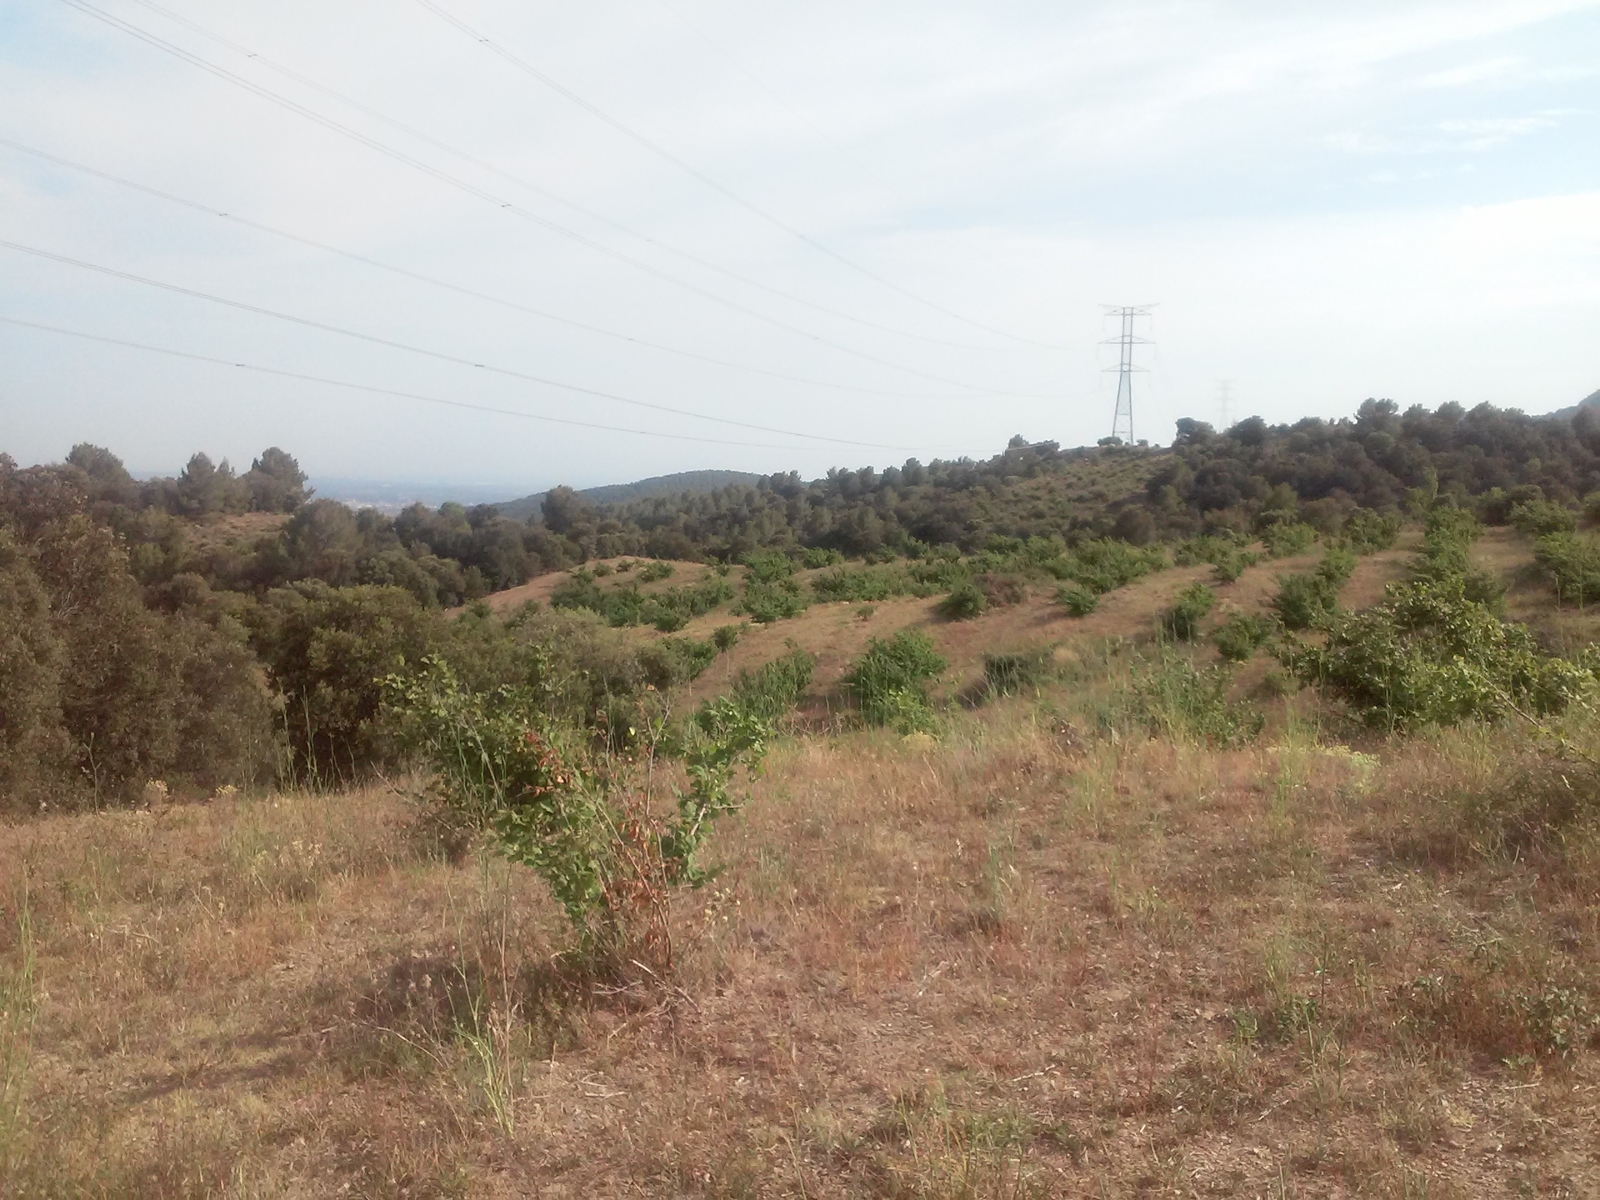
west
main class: Cropland
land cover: Nuts trees
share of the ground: < 10 %
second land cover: Grassland without tree/shrub cover
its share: > 75 %
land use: Agriculture (excluding fallow land and kitchen gardens)
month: June
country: ES
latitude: 41.3668
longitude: 1.2529
